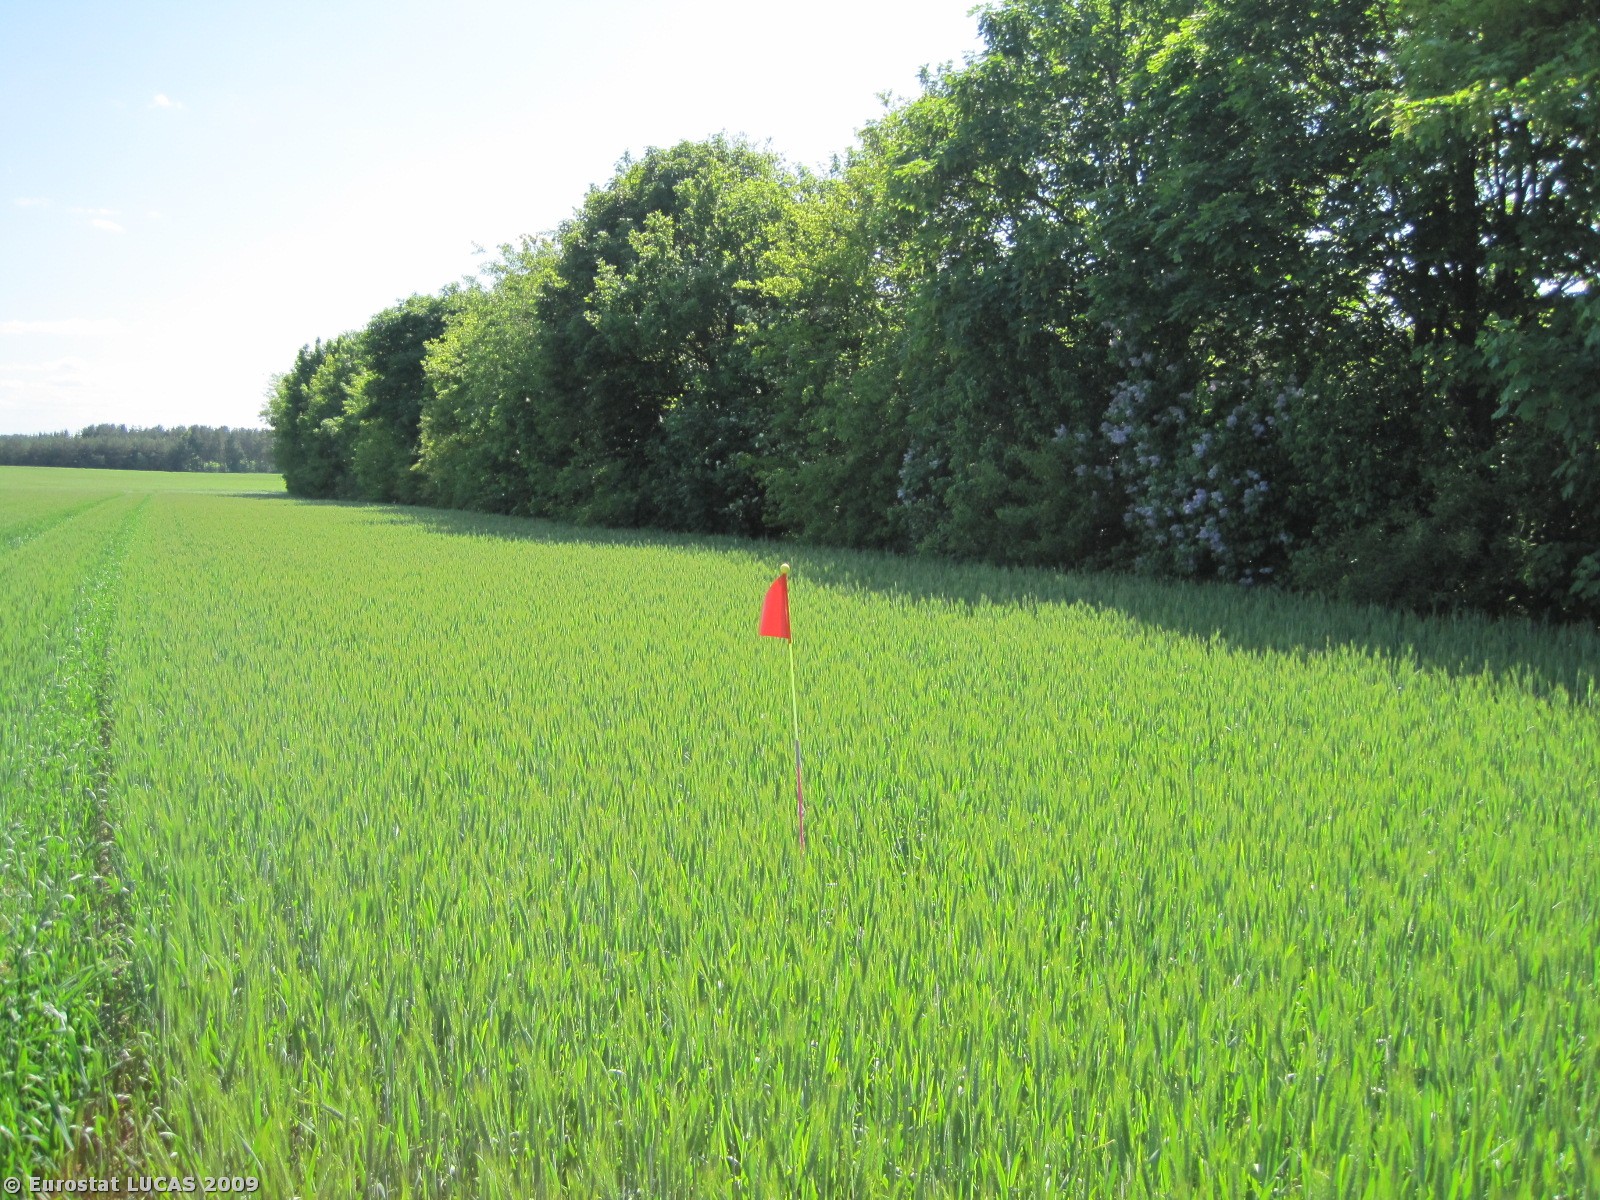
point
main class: Cropland
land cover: Barley
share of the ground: > 75 %
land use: Agriculture (excluding fallow land and kitchen gardens)
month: May
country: DK
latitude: 56.4572
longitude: 10.2107
